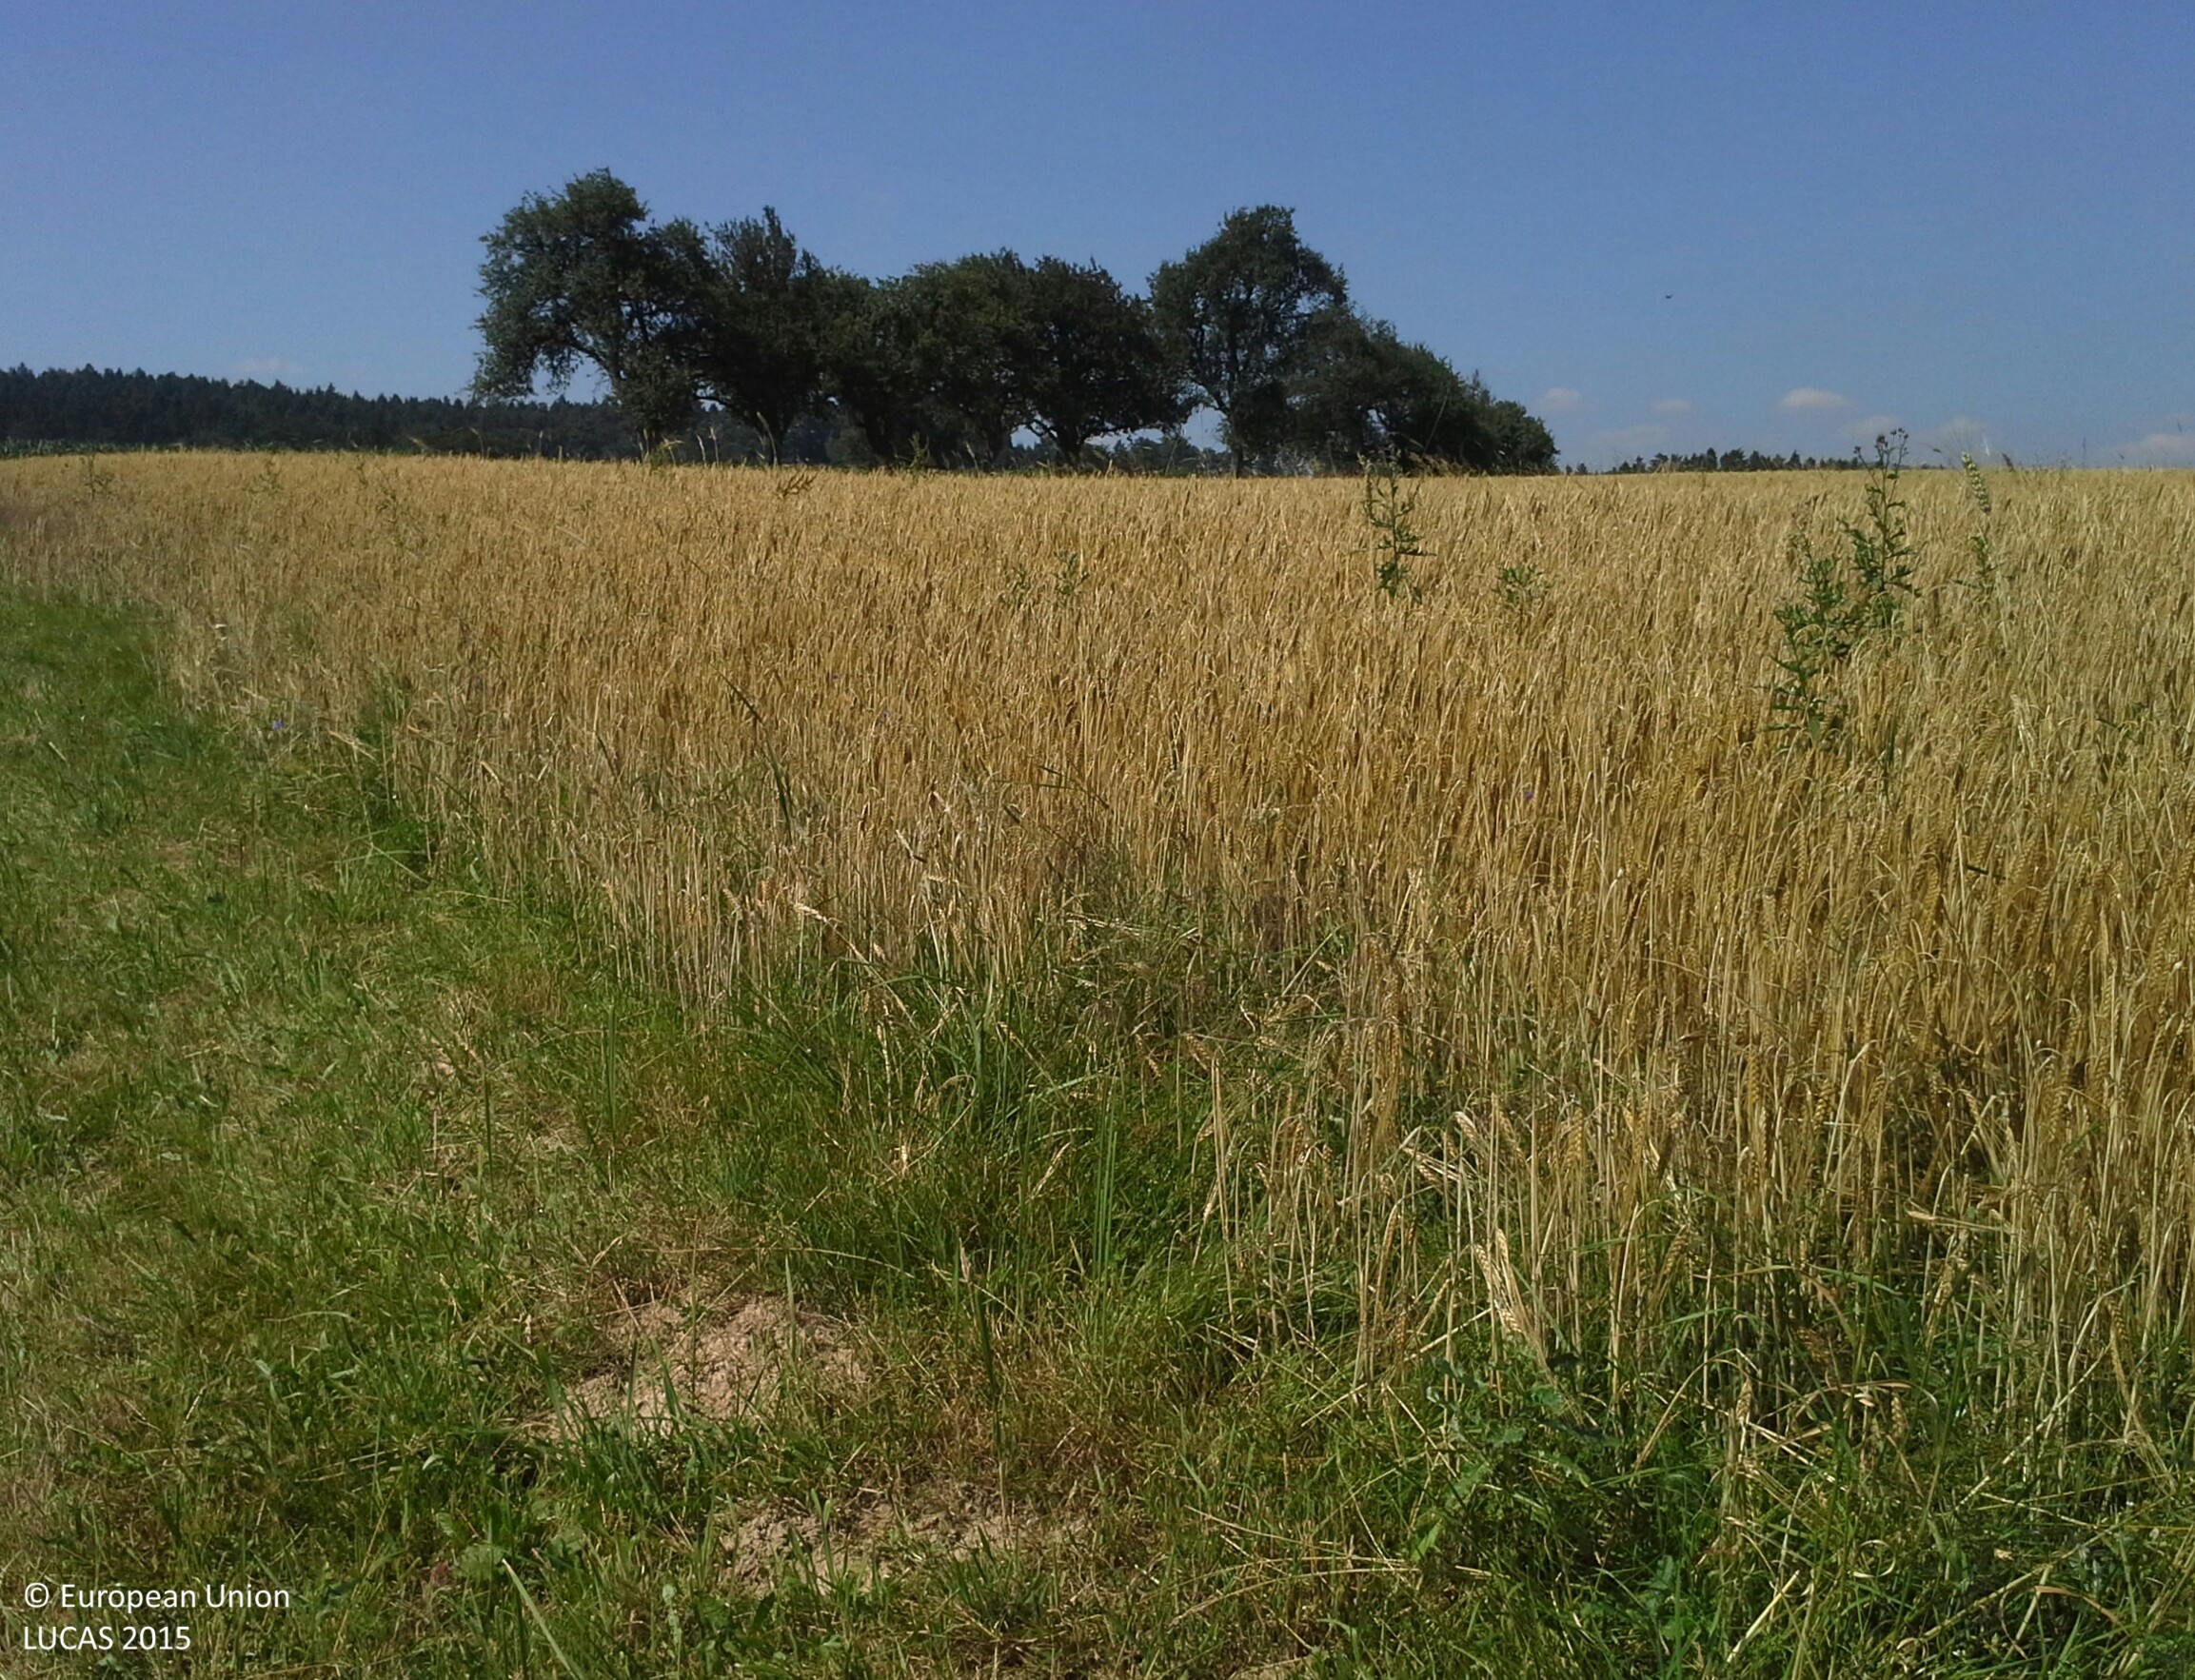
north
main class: Grassland
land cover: Grassland without tree/shrub cover
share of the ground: > 75 %
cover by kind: herbaceous plants 100 %
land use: Agriculture (excluding fallow land and kitchen gardens)
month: July
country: AT
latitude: 48.1802
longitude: 15.0448
